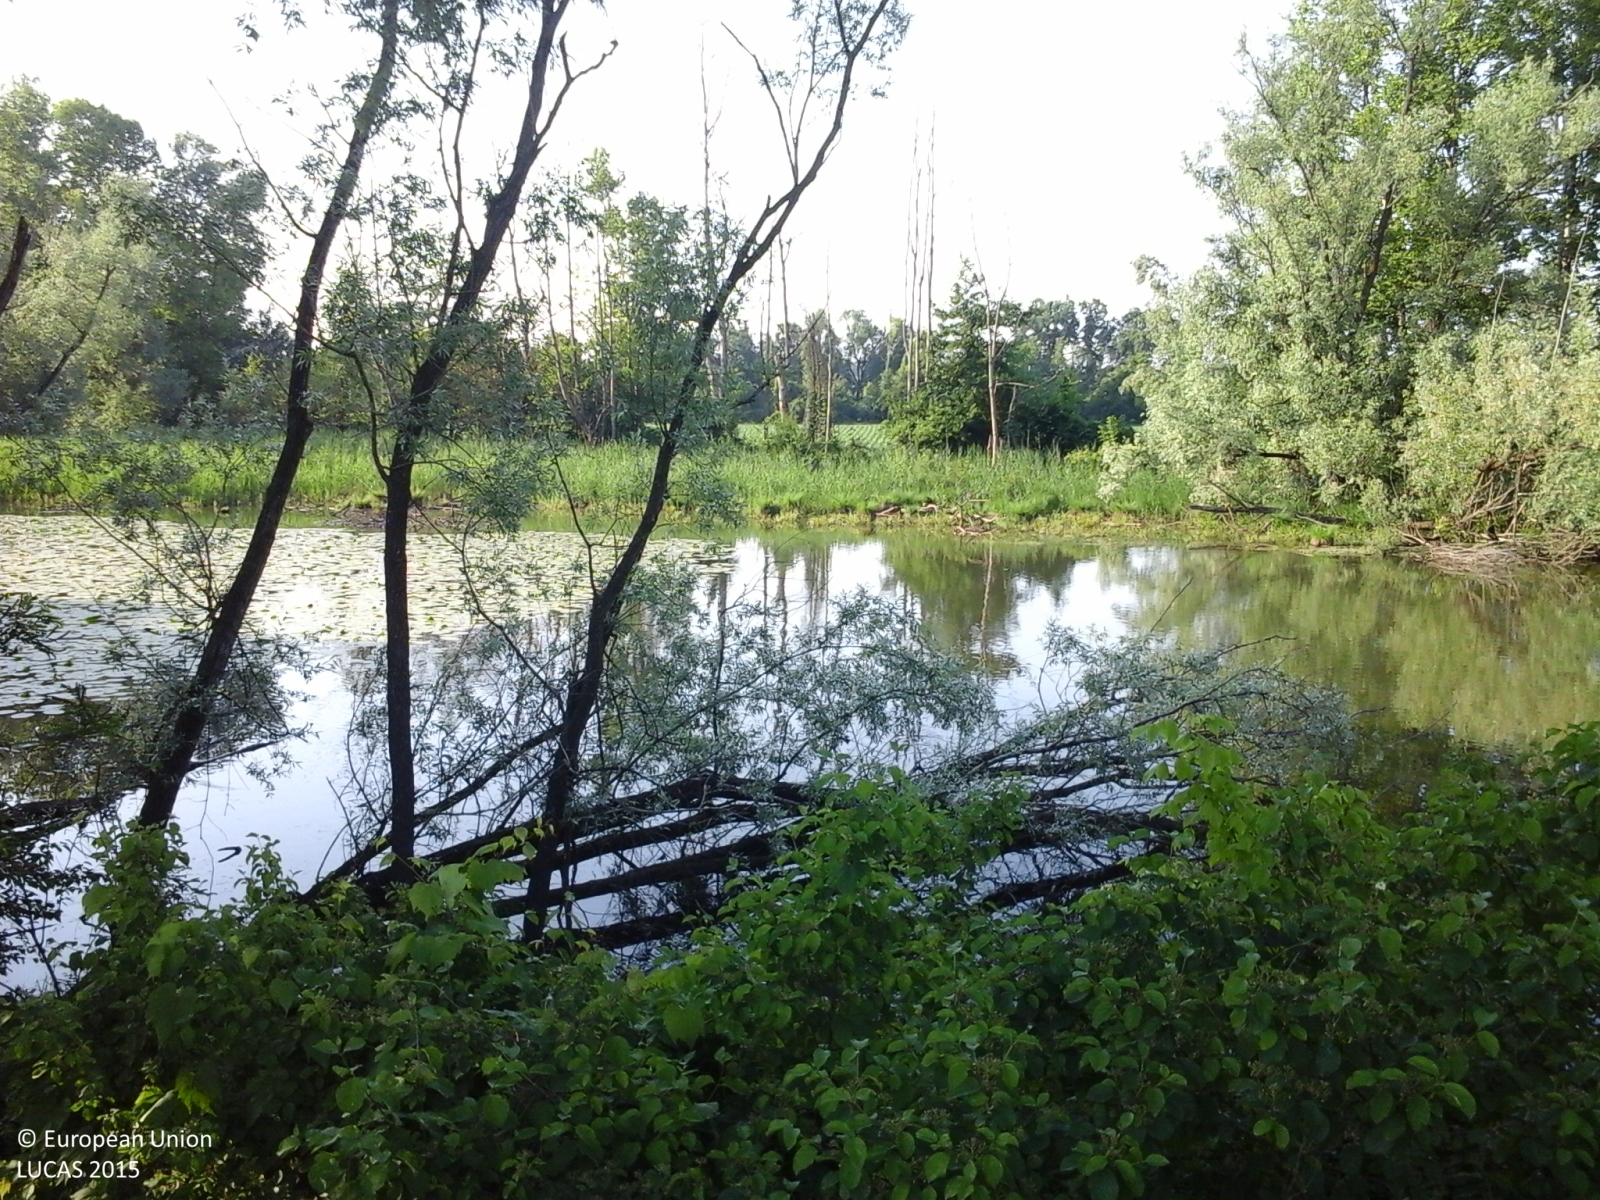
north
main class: Cropland
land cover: Maize
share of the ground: > 75 %
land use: Agriculture (excluding fallow land and kitchen gardens)
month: May
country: IT
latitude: 45.2874
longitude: 9.6055
